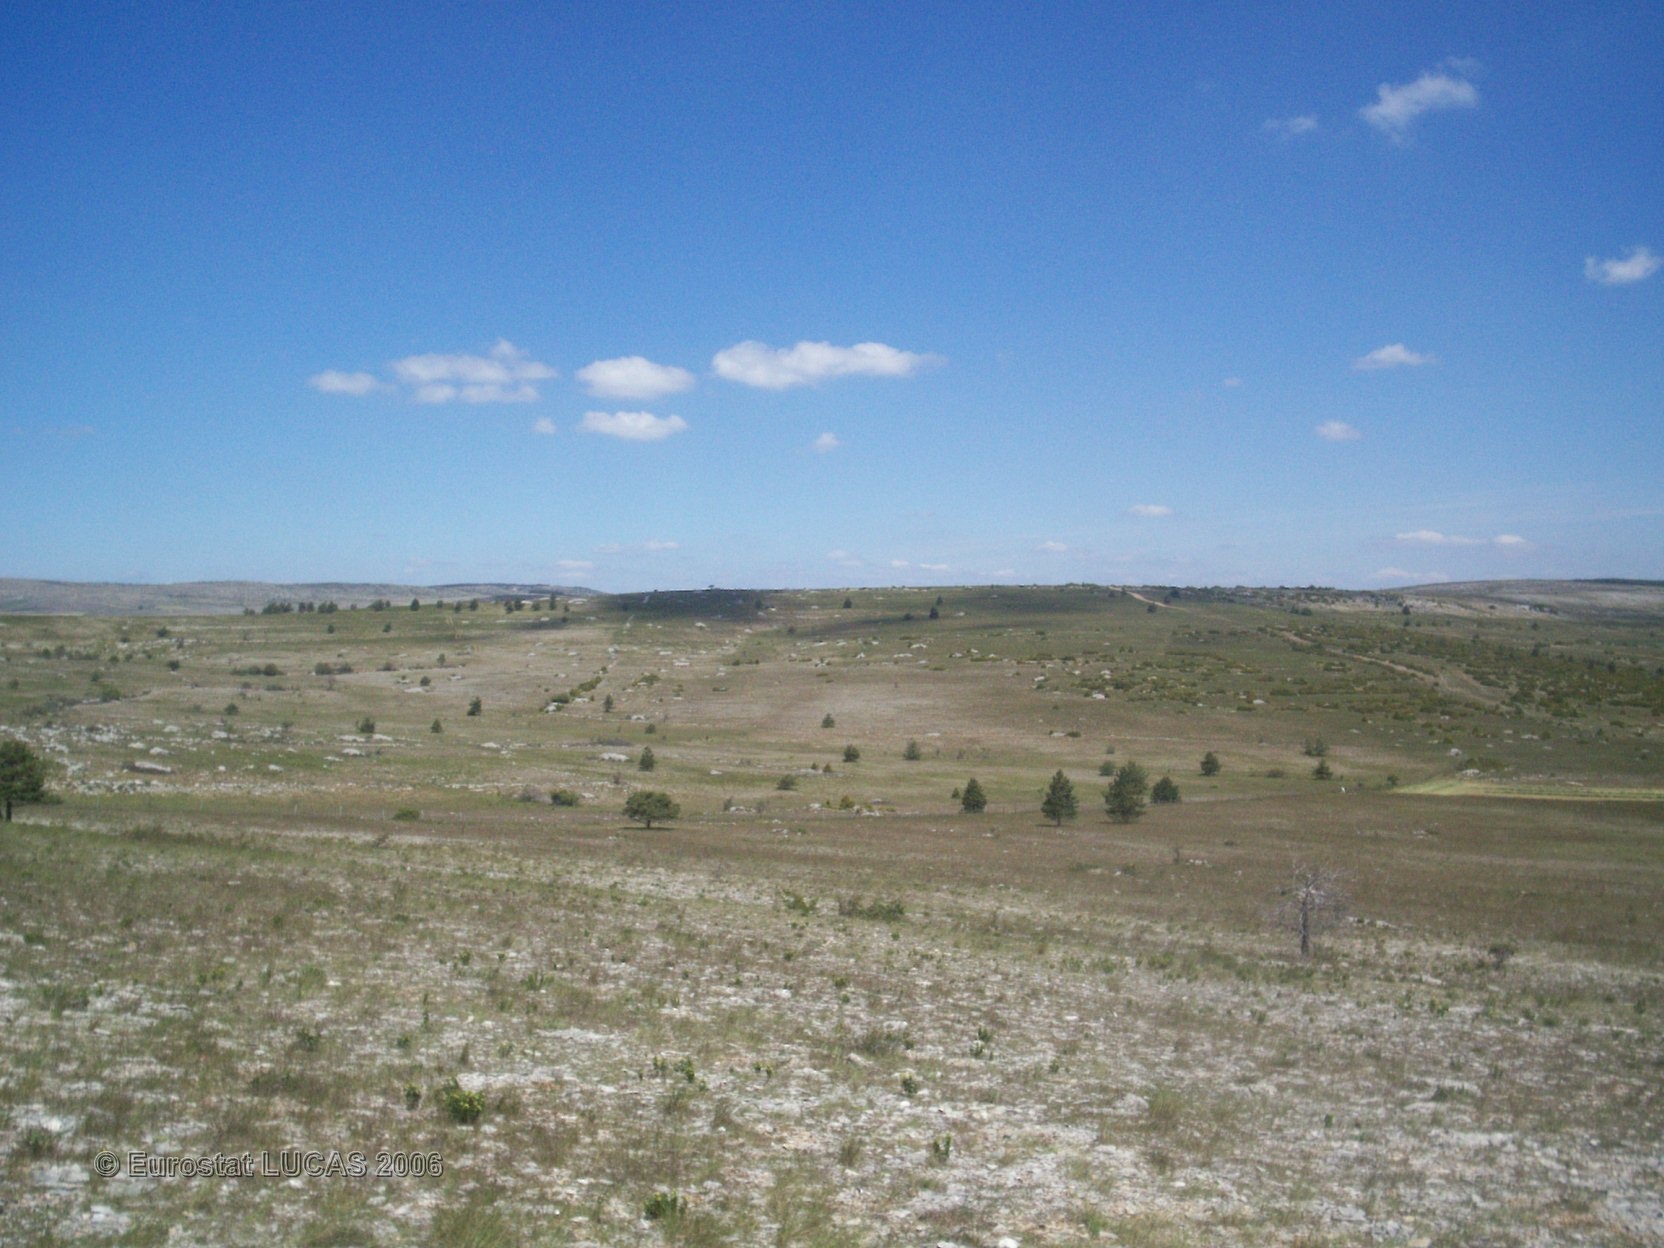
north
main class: Grassland
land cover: Grassland without tree/shrub cover
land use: Agriculture (excluding fallow land and kitchen gardens)
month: June
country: FR
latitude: 44.2134
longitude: 3.4103
